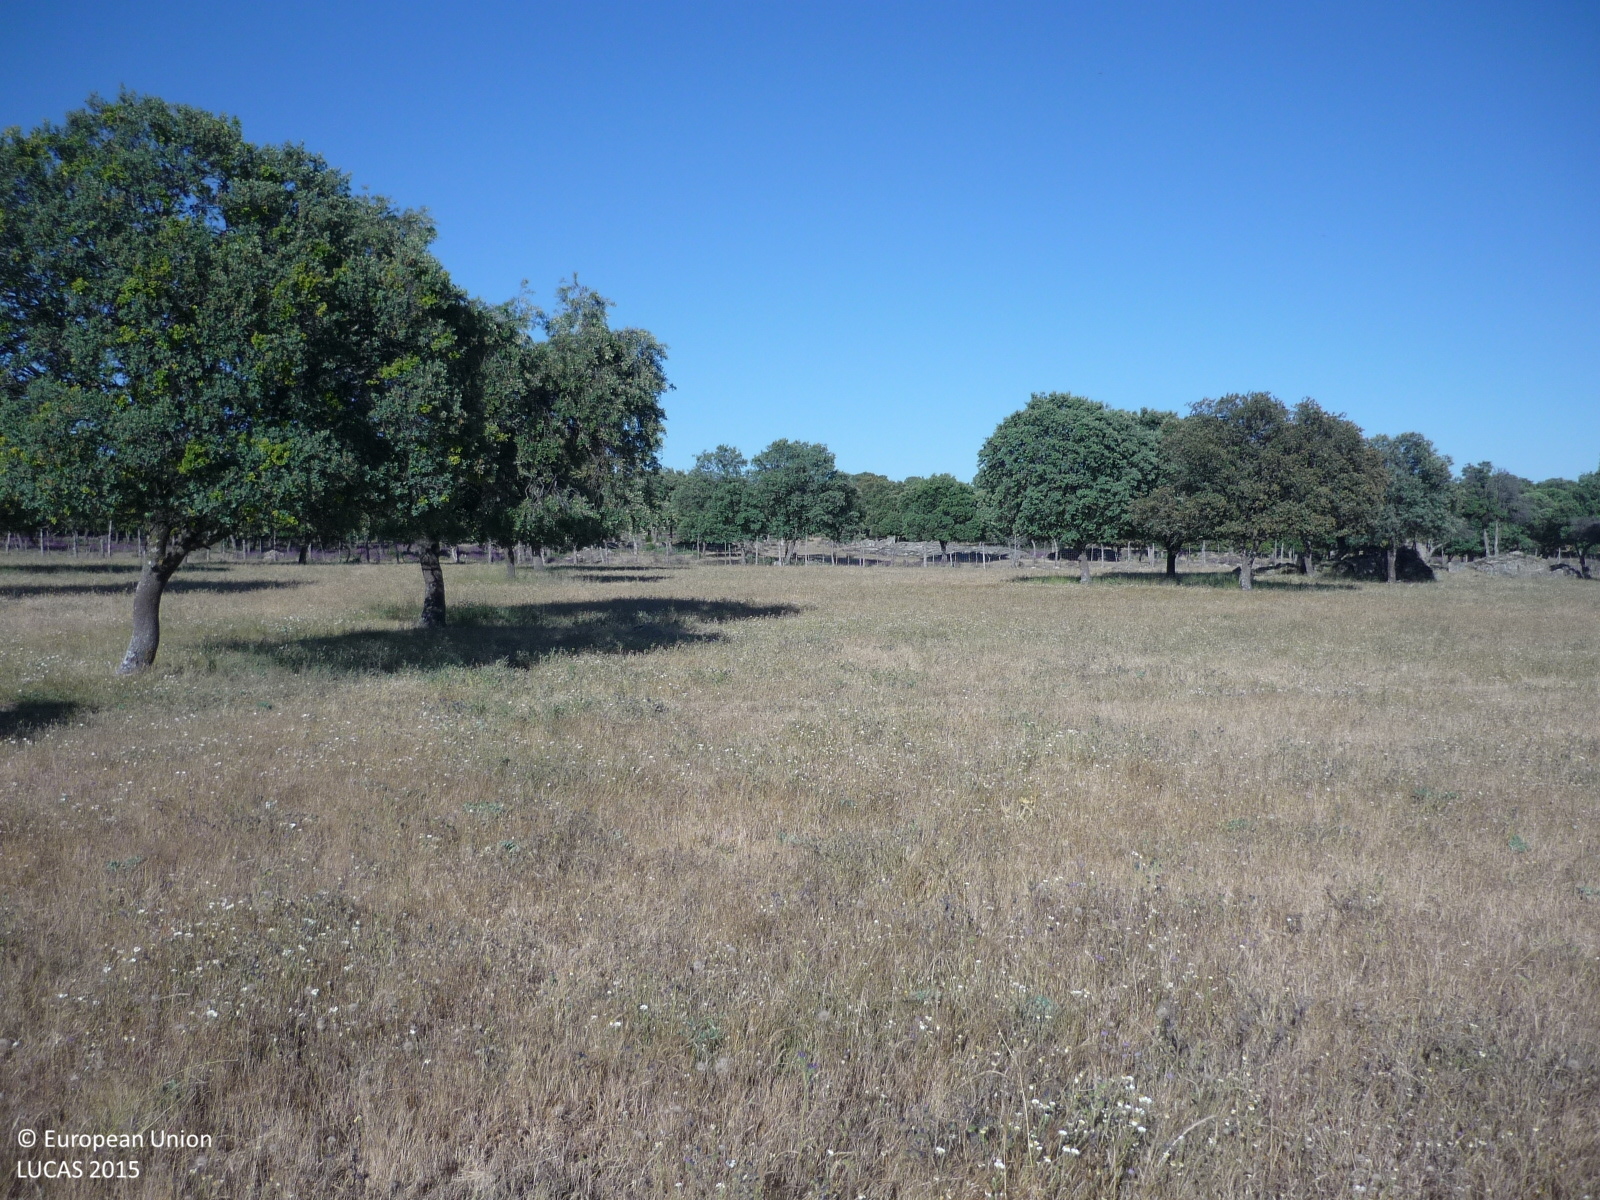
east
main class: Grassland
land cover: Grassland with sparse tree/shrub cover
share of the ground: > 75 %
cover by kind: herbaceous plants 90 %, broadleaved forest trees 5 %, shrubs 5 %
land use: Agriculture (excluding fallow land and kitchen gardens)
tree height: < 5 m
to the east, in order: Grassland with sparse tree/shrub cover; Fences; Grassland with sparse tree/shrub cover; Dry stone walls; Grassland with sparse tree/shrub cover; Rock outcrops; Grassland with sparse tree/shrub cover
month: May
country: ES
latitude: 40.6869
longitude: -3.8758
